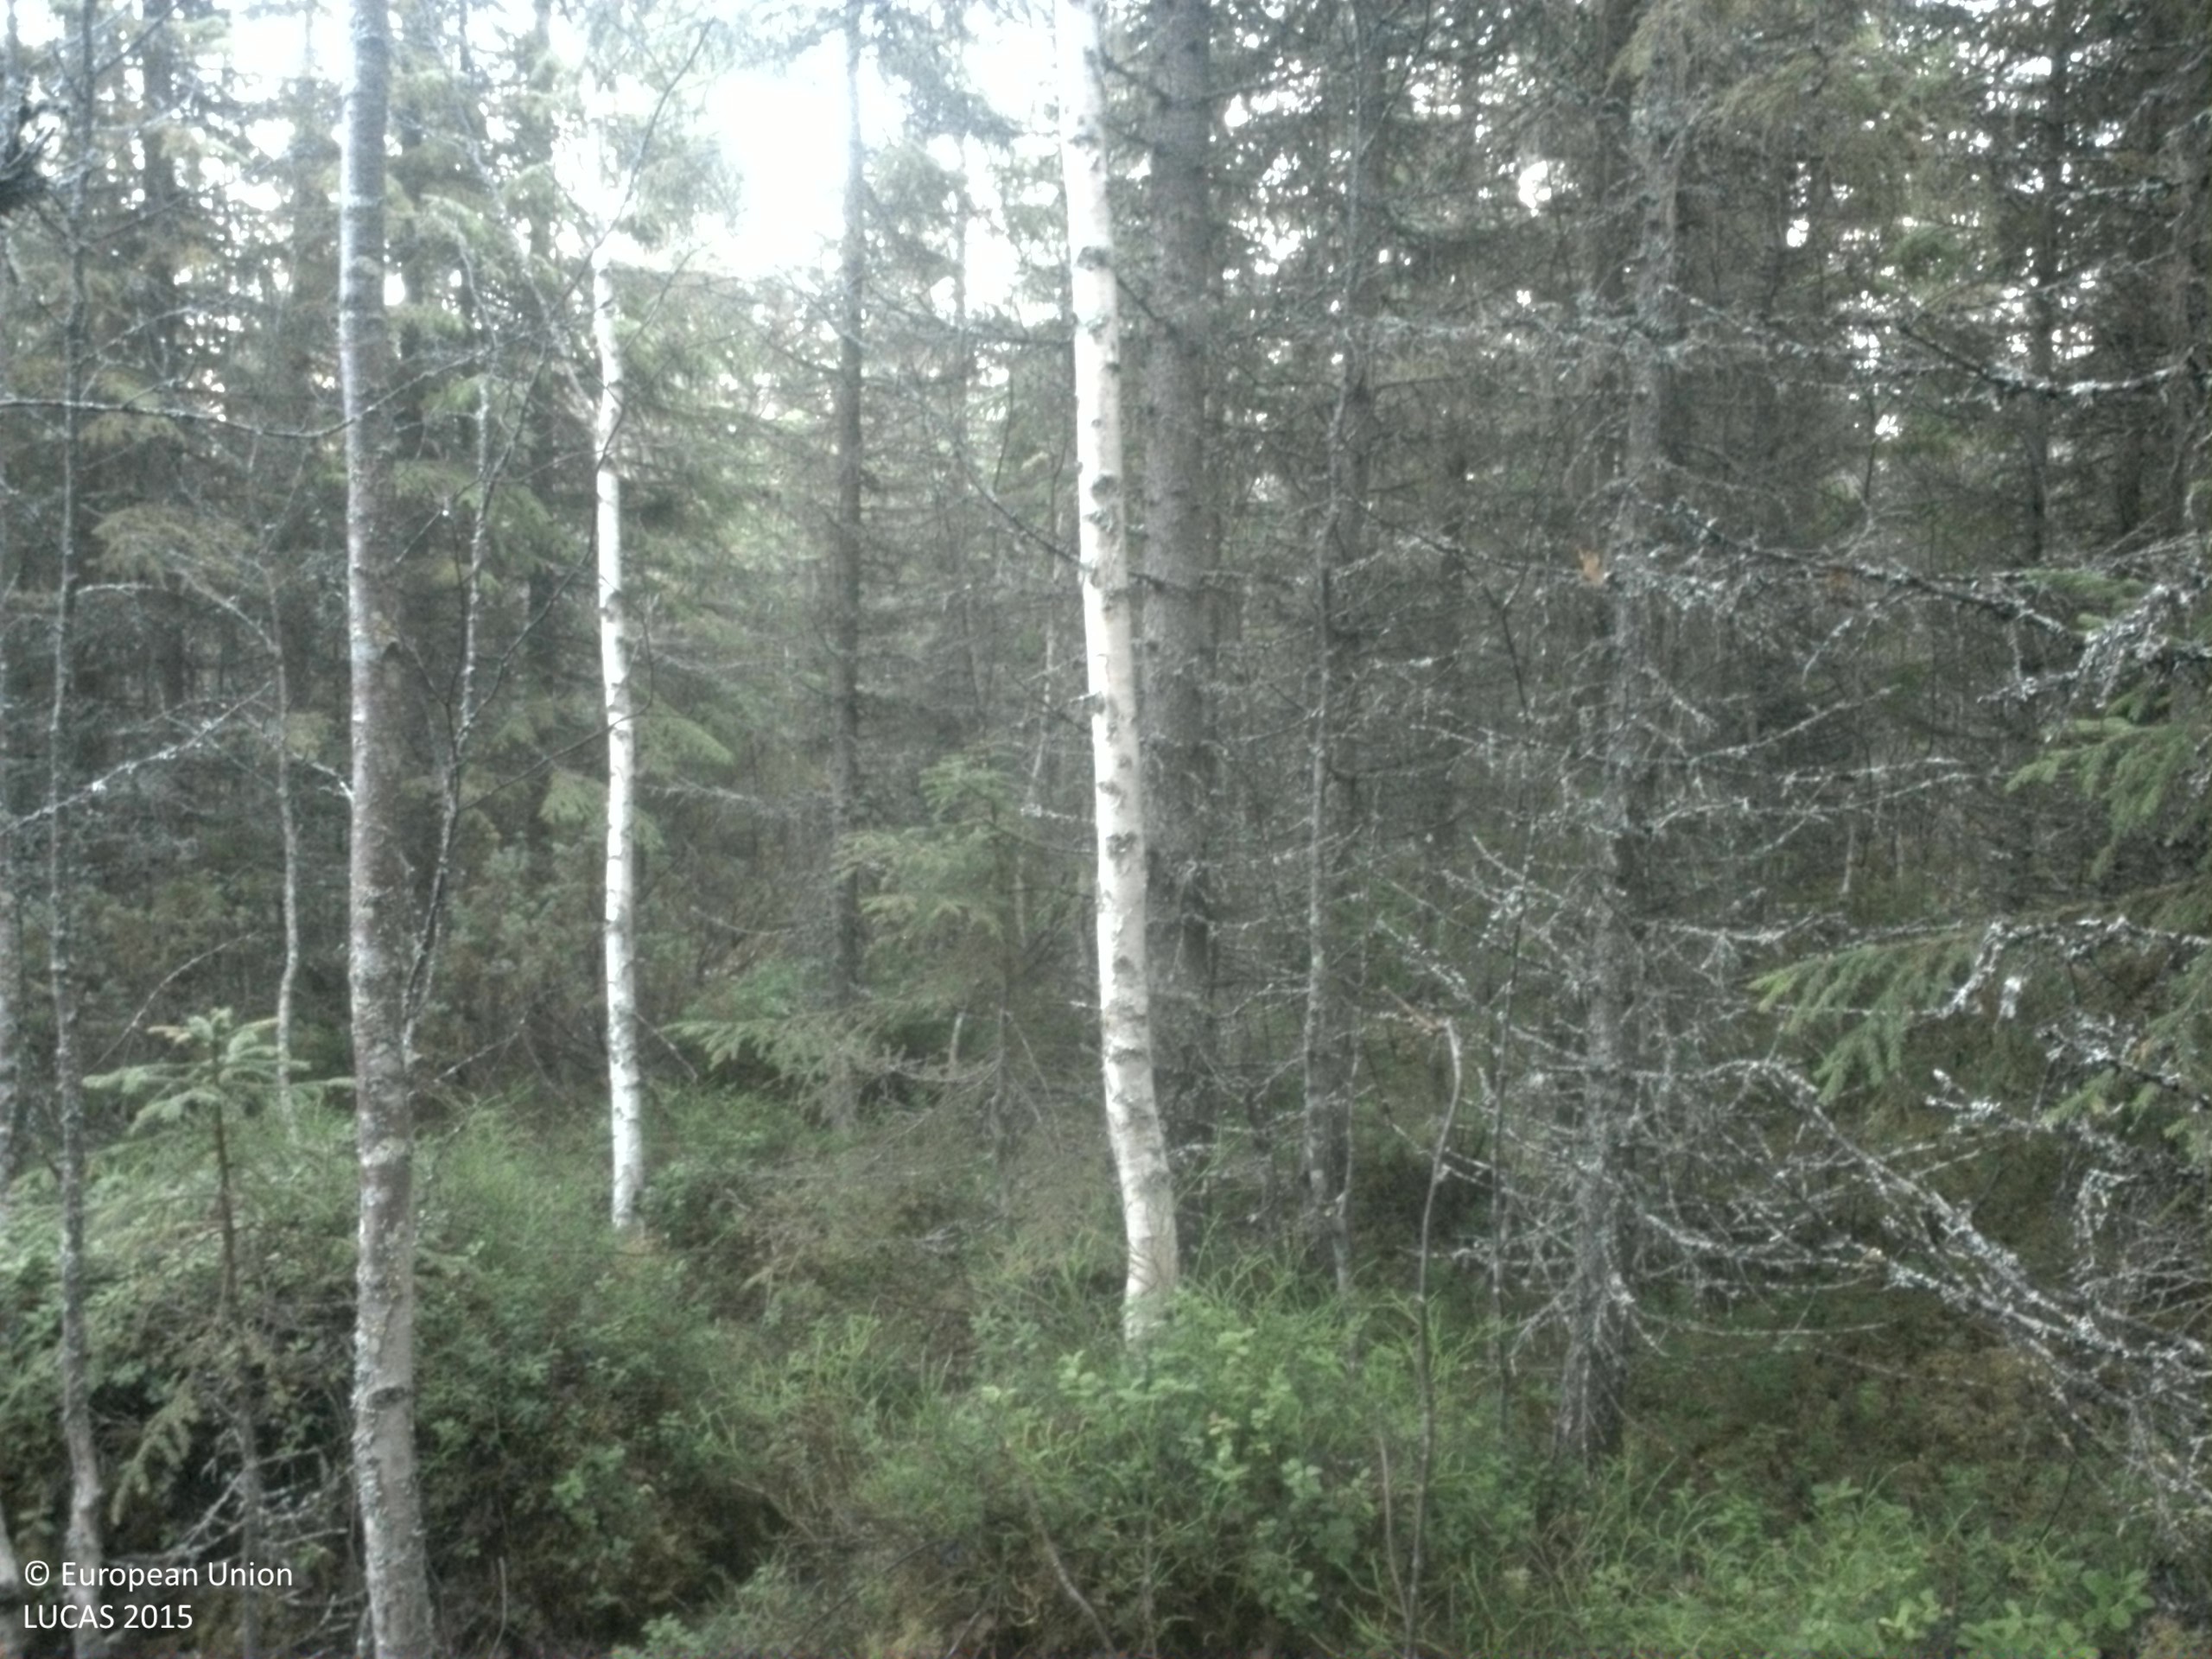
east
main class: Woodland
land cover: Spruce dominated mixed woodland
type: boreal forest
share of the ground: > 75 %
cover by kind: coniferous forest trees 55 %, broadleaved forest trees 20 %, shrubs 15 %, lichens and mosses 10 %
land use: Forestry
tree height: > 5 m
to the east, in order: Spruce dominated mixed woodland
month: November
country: SE
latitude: 63.9081
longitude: 15.9025
